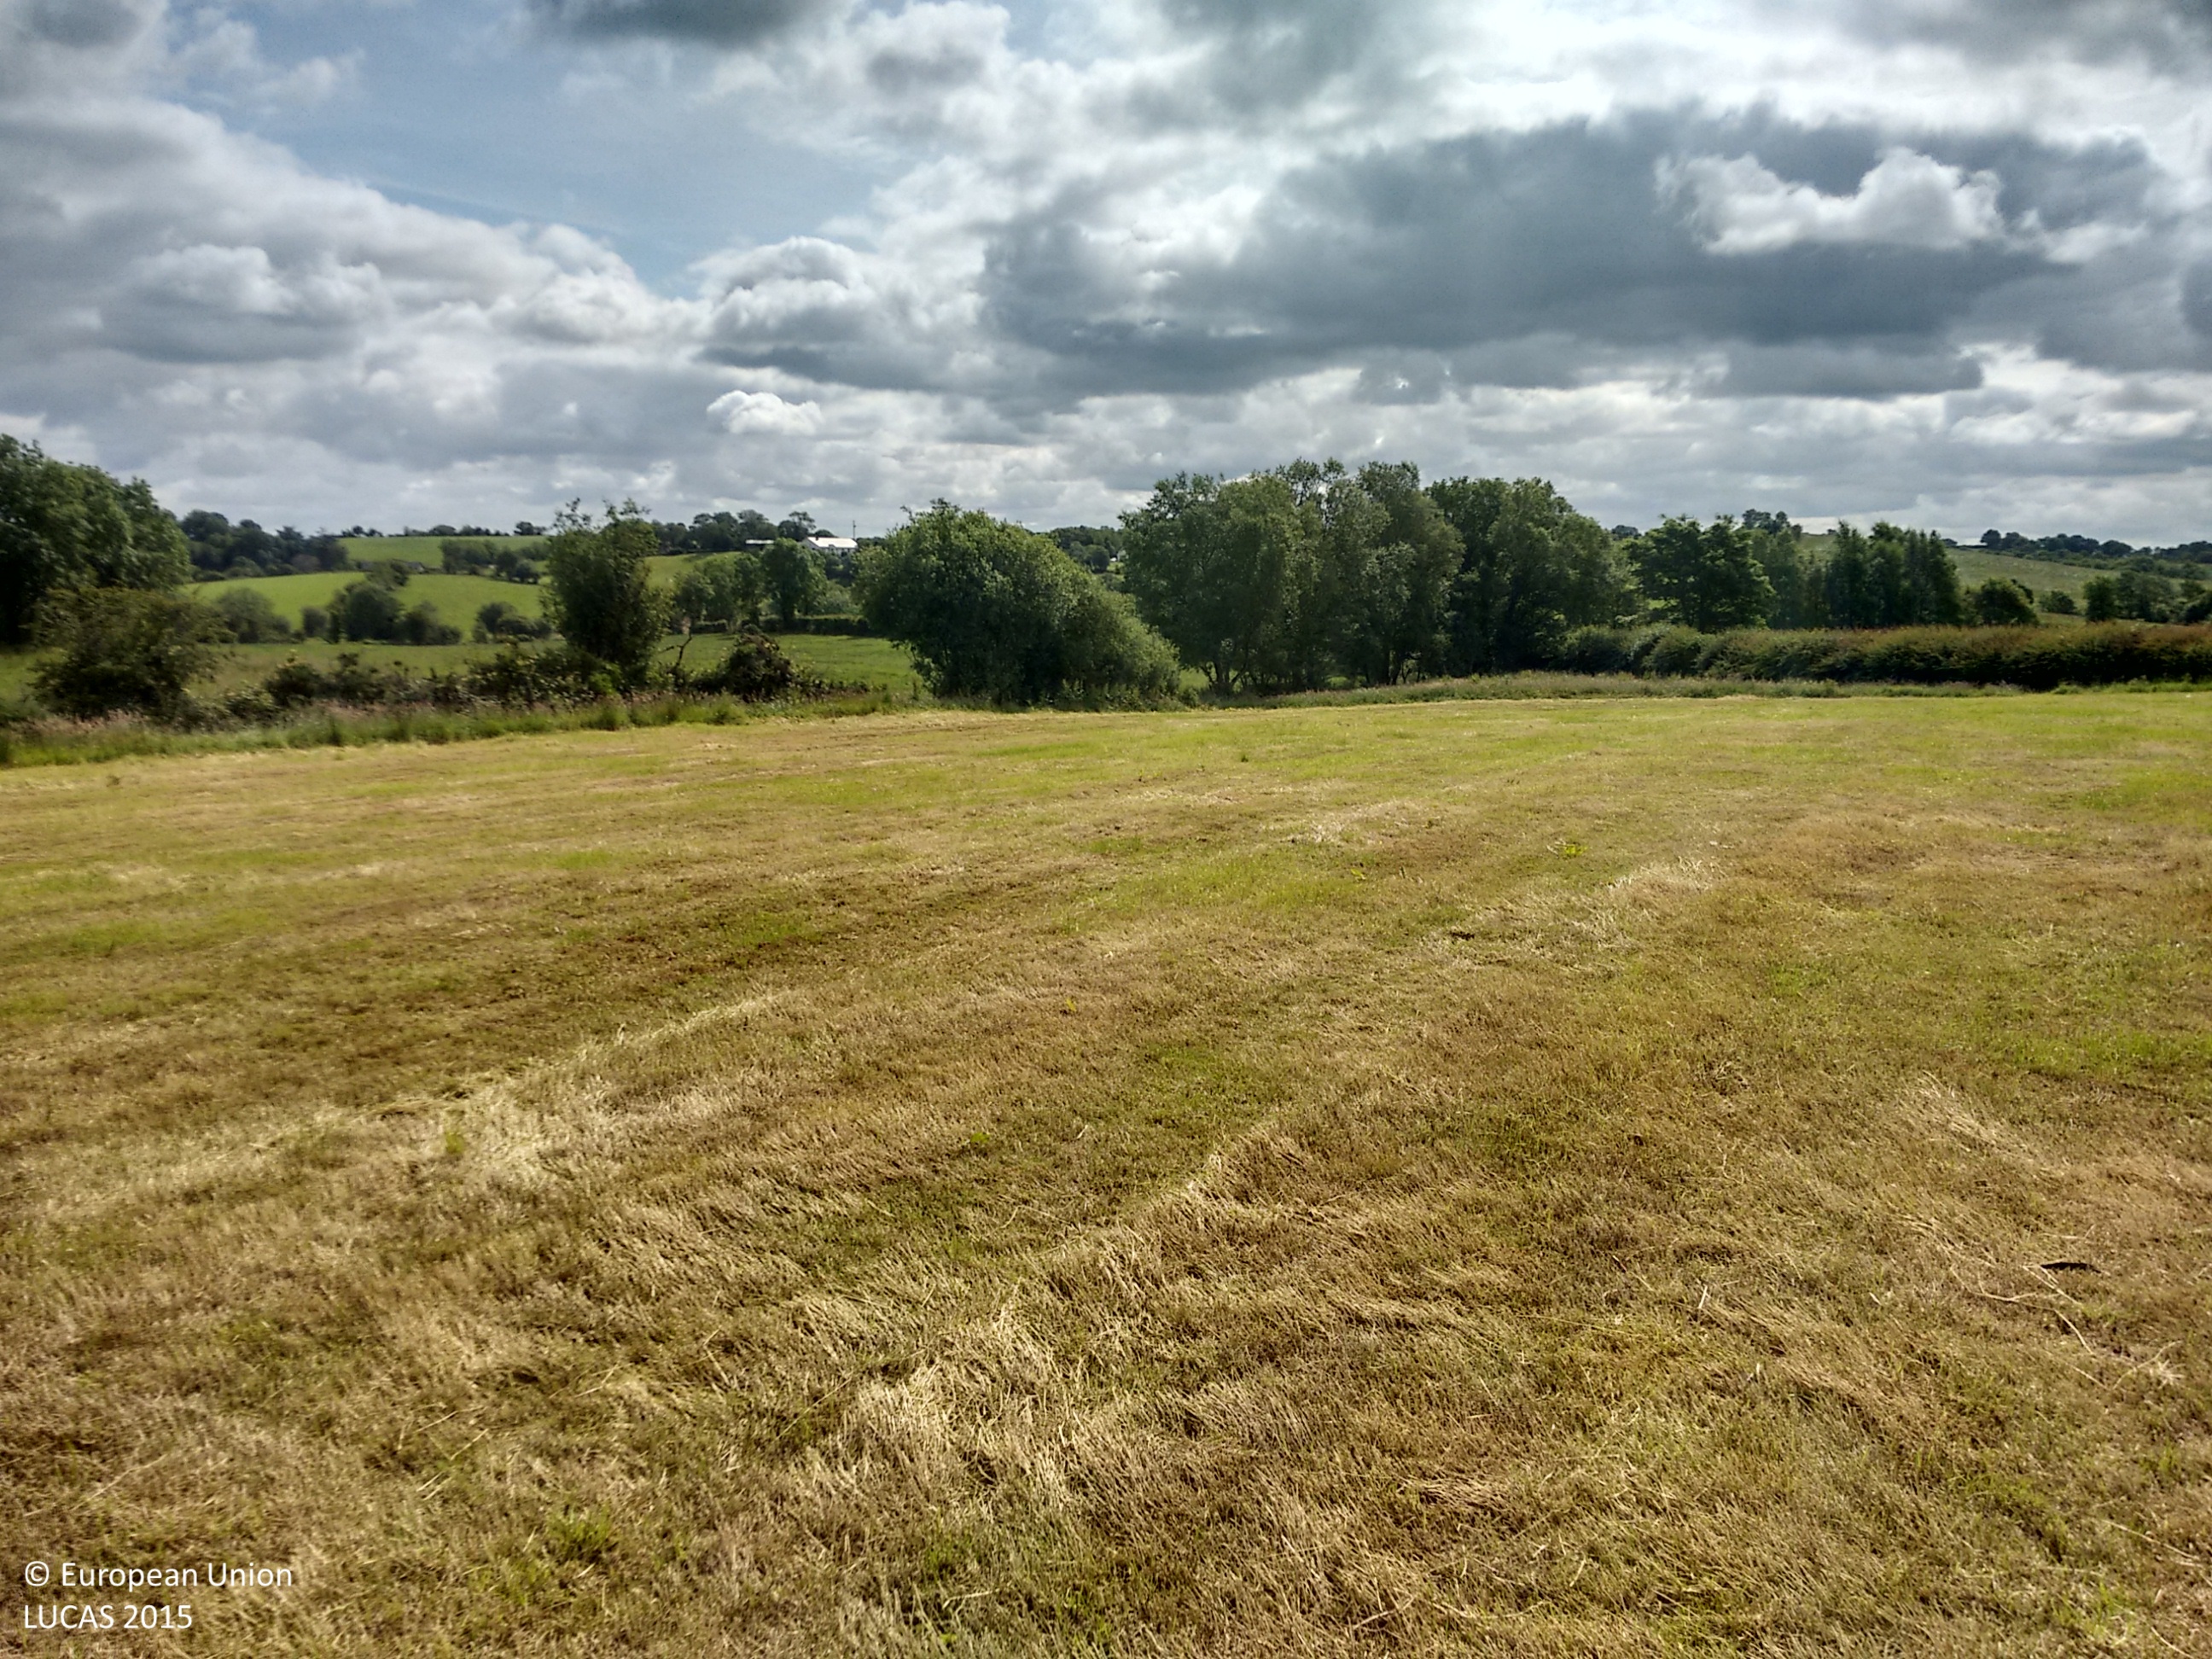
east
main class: Grassland
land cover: Grassland without tree/shrub cover
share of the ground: > 75 %
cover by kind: herbaceous plants 100 %
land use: Agriculture (excluding fallow land and kitchen gardens)
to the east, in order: Grassland without tree/shrub cover; Ditches and canals; Abandoned hedges; Fences; Grassland without tree/shrub cover; Fences; Ditches and canals; Abandoned hedges; Grass margins; Paved roads, cycling and walking lanes; Grass margins; Ditches and canals; Abandoned hedges; Fences; Grassland without tree/shrub cover
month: July
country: GB
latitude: 54.6001
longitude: -7.3799
